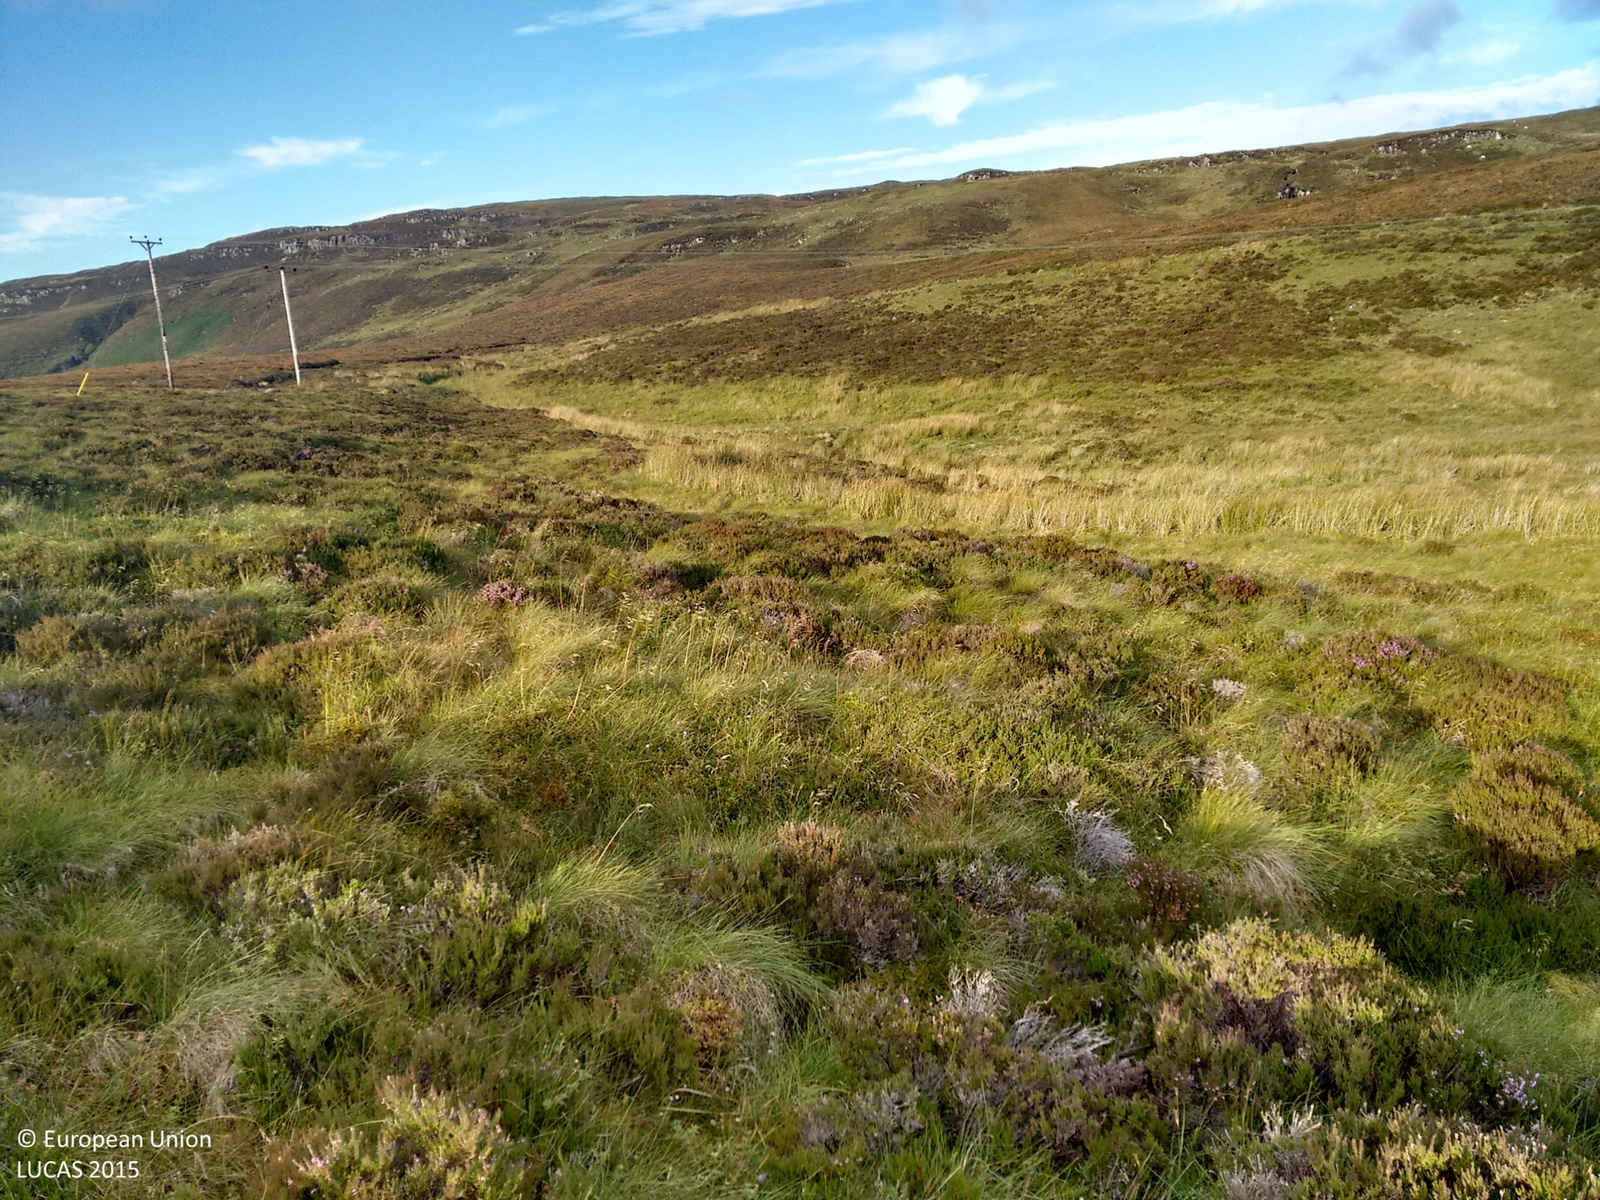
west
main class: Shrubland
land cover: Shrubland without tree cover
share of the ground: > 75 %
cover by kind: shrubs 75 %, herbaceous plants 25 %
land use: Agriculture (excluding fallow land and kitchen gardens)
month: September
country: GB
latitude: 57.4496
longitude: -6.1814
